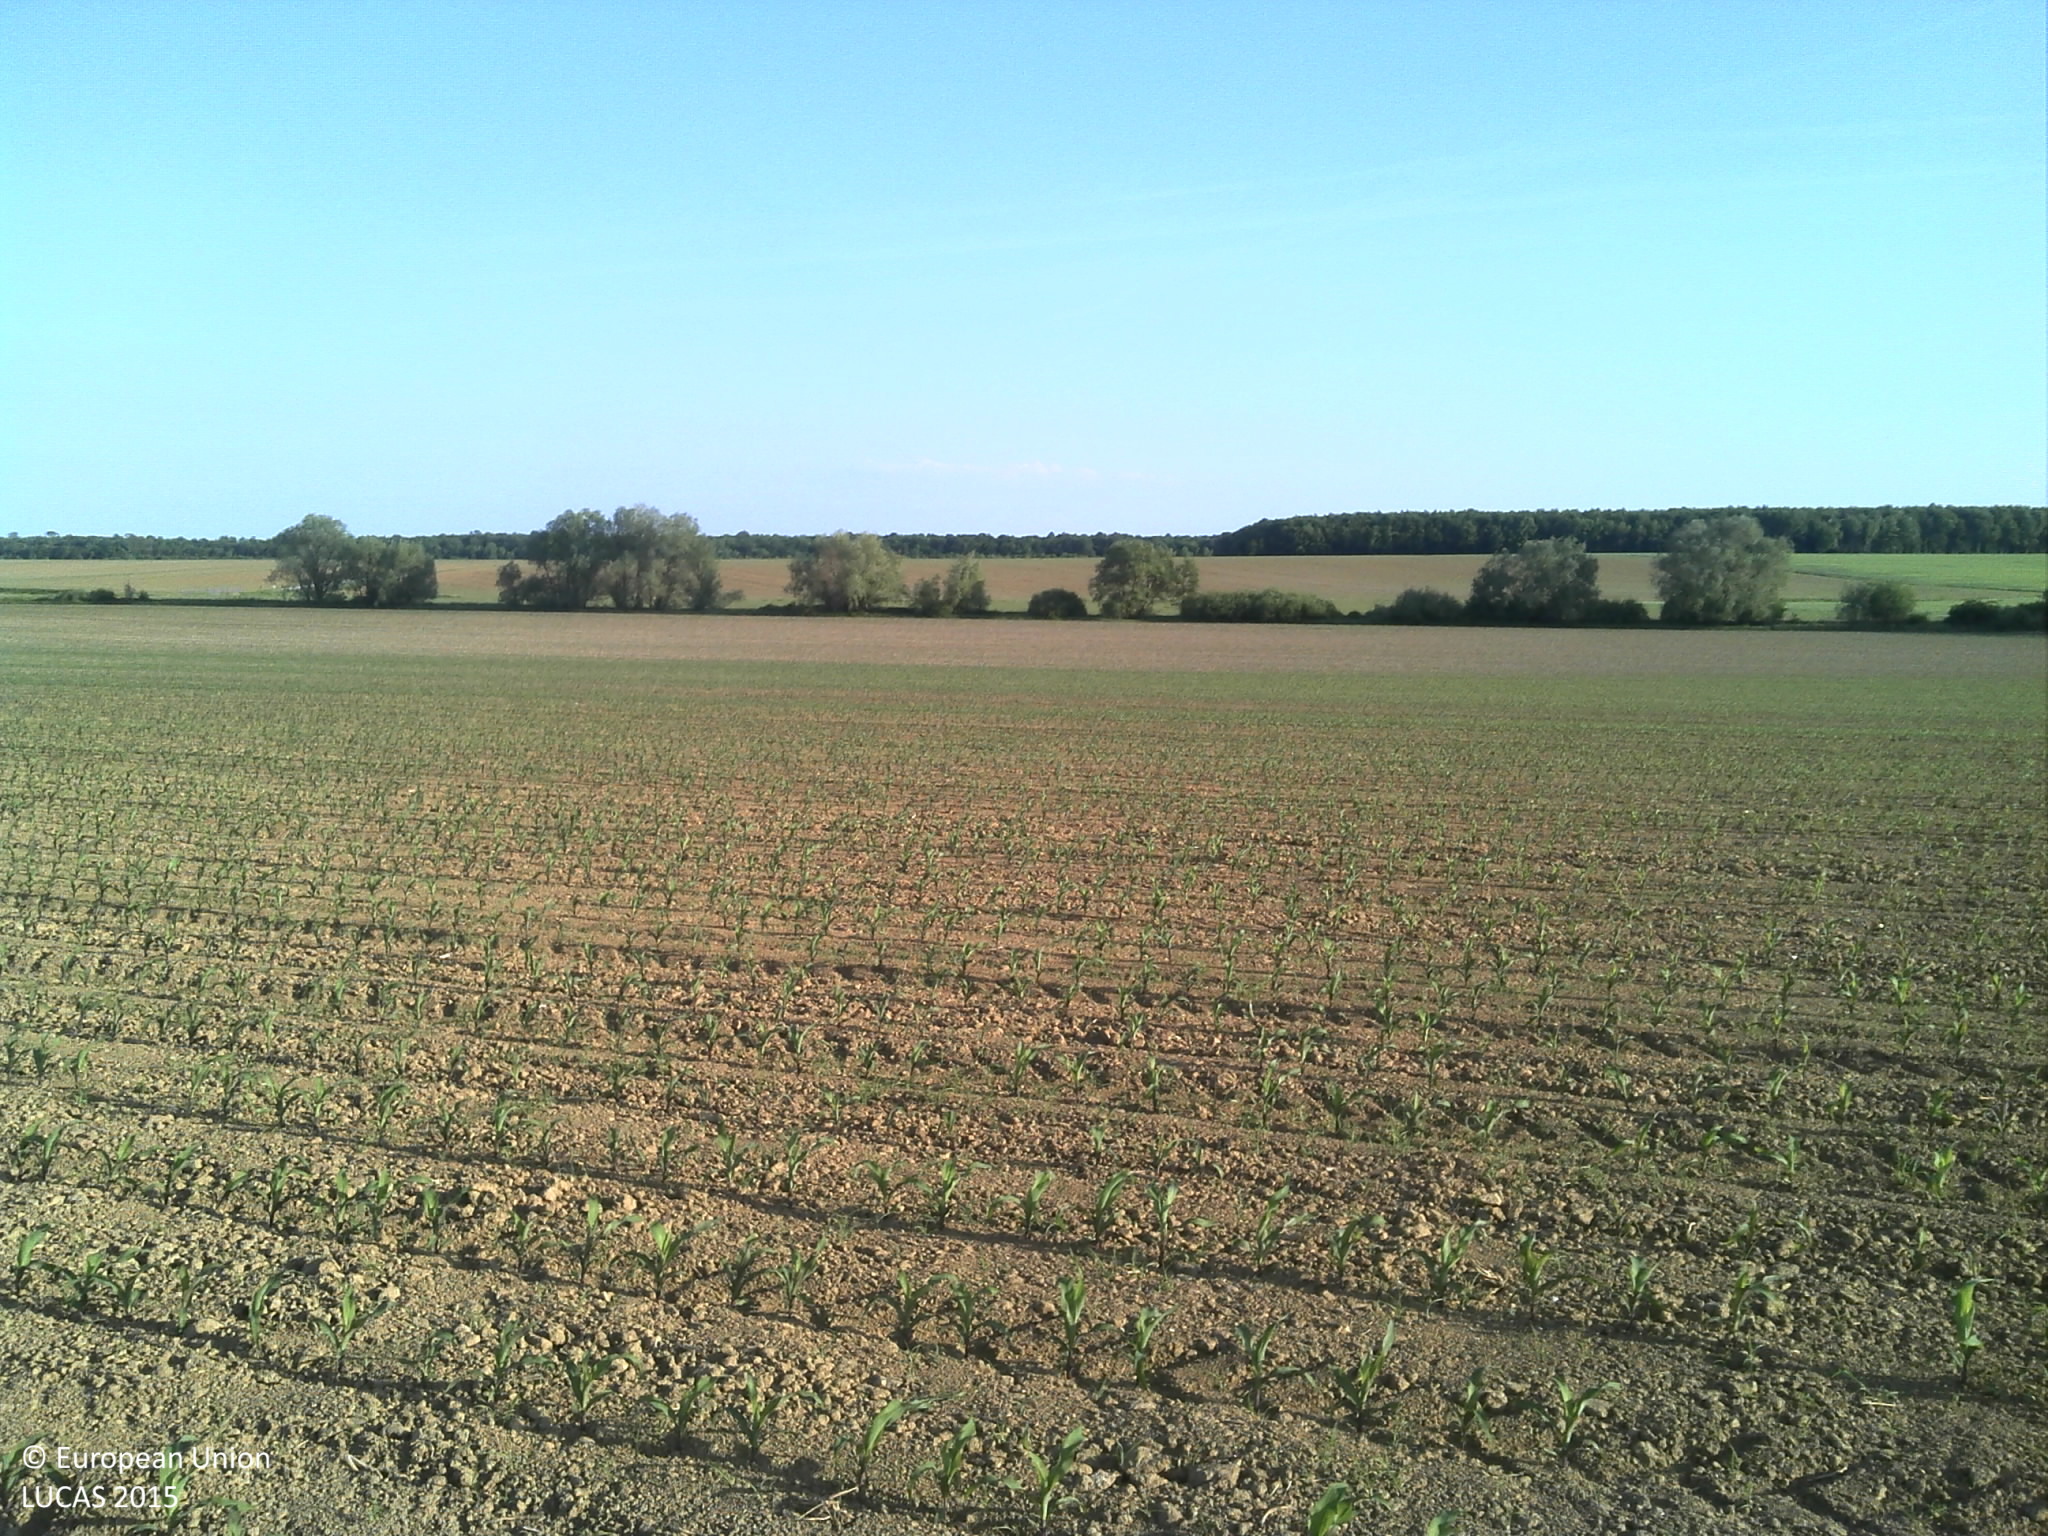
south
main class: Cropland
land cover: Maize
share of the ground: < 10 %
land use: Agriculture (excluding fallow land and kitchen gardens)
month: May
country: HR
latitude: 45.2358
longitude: 18.2455
